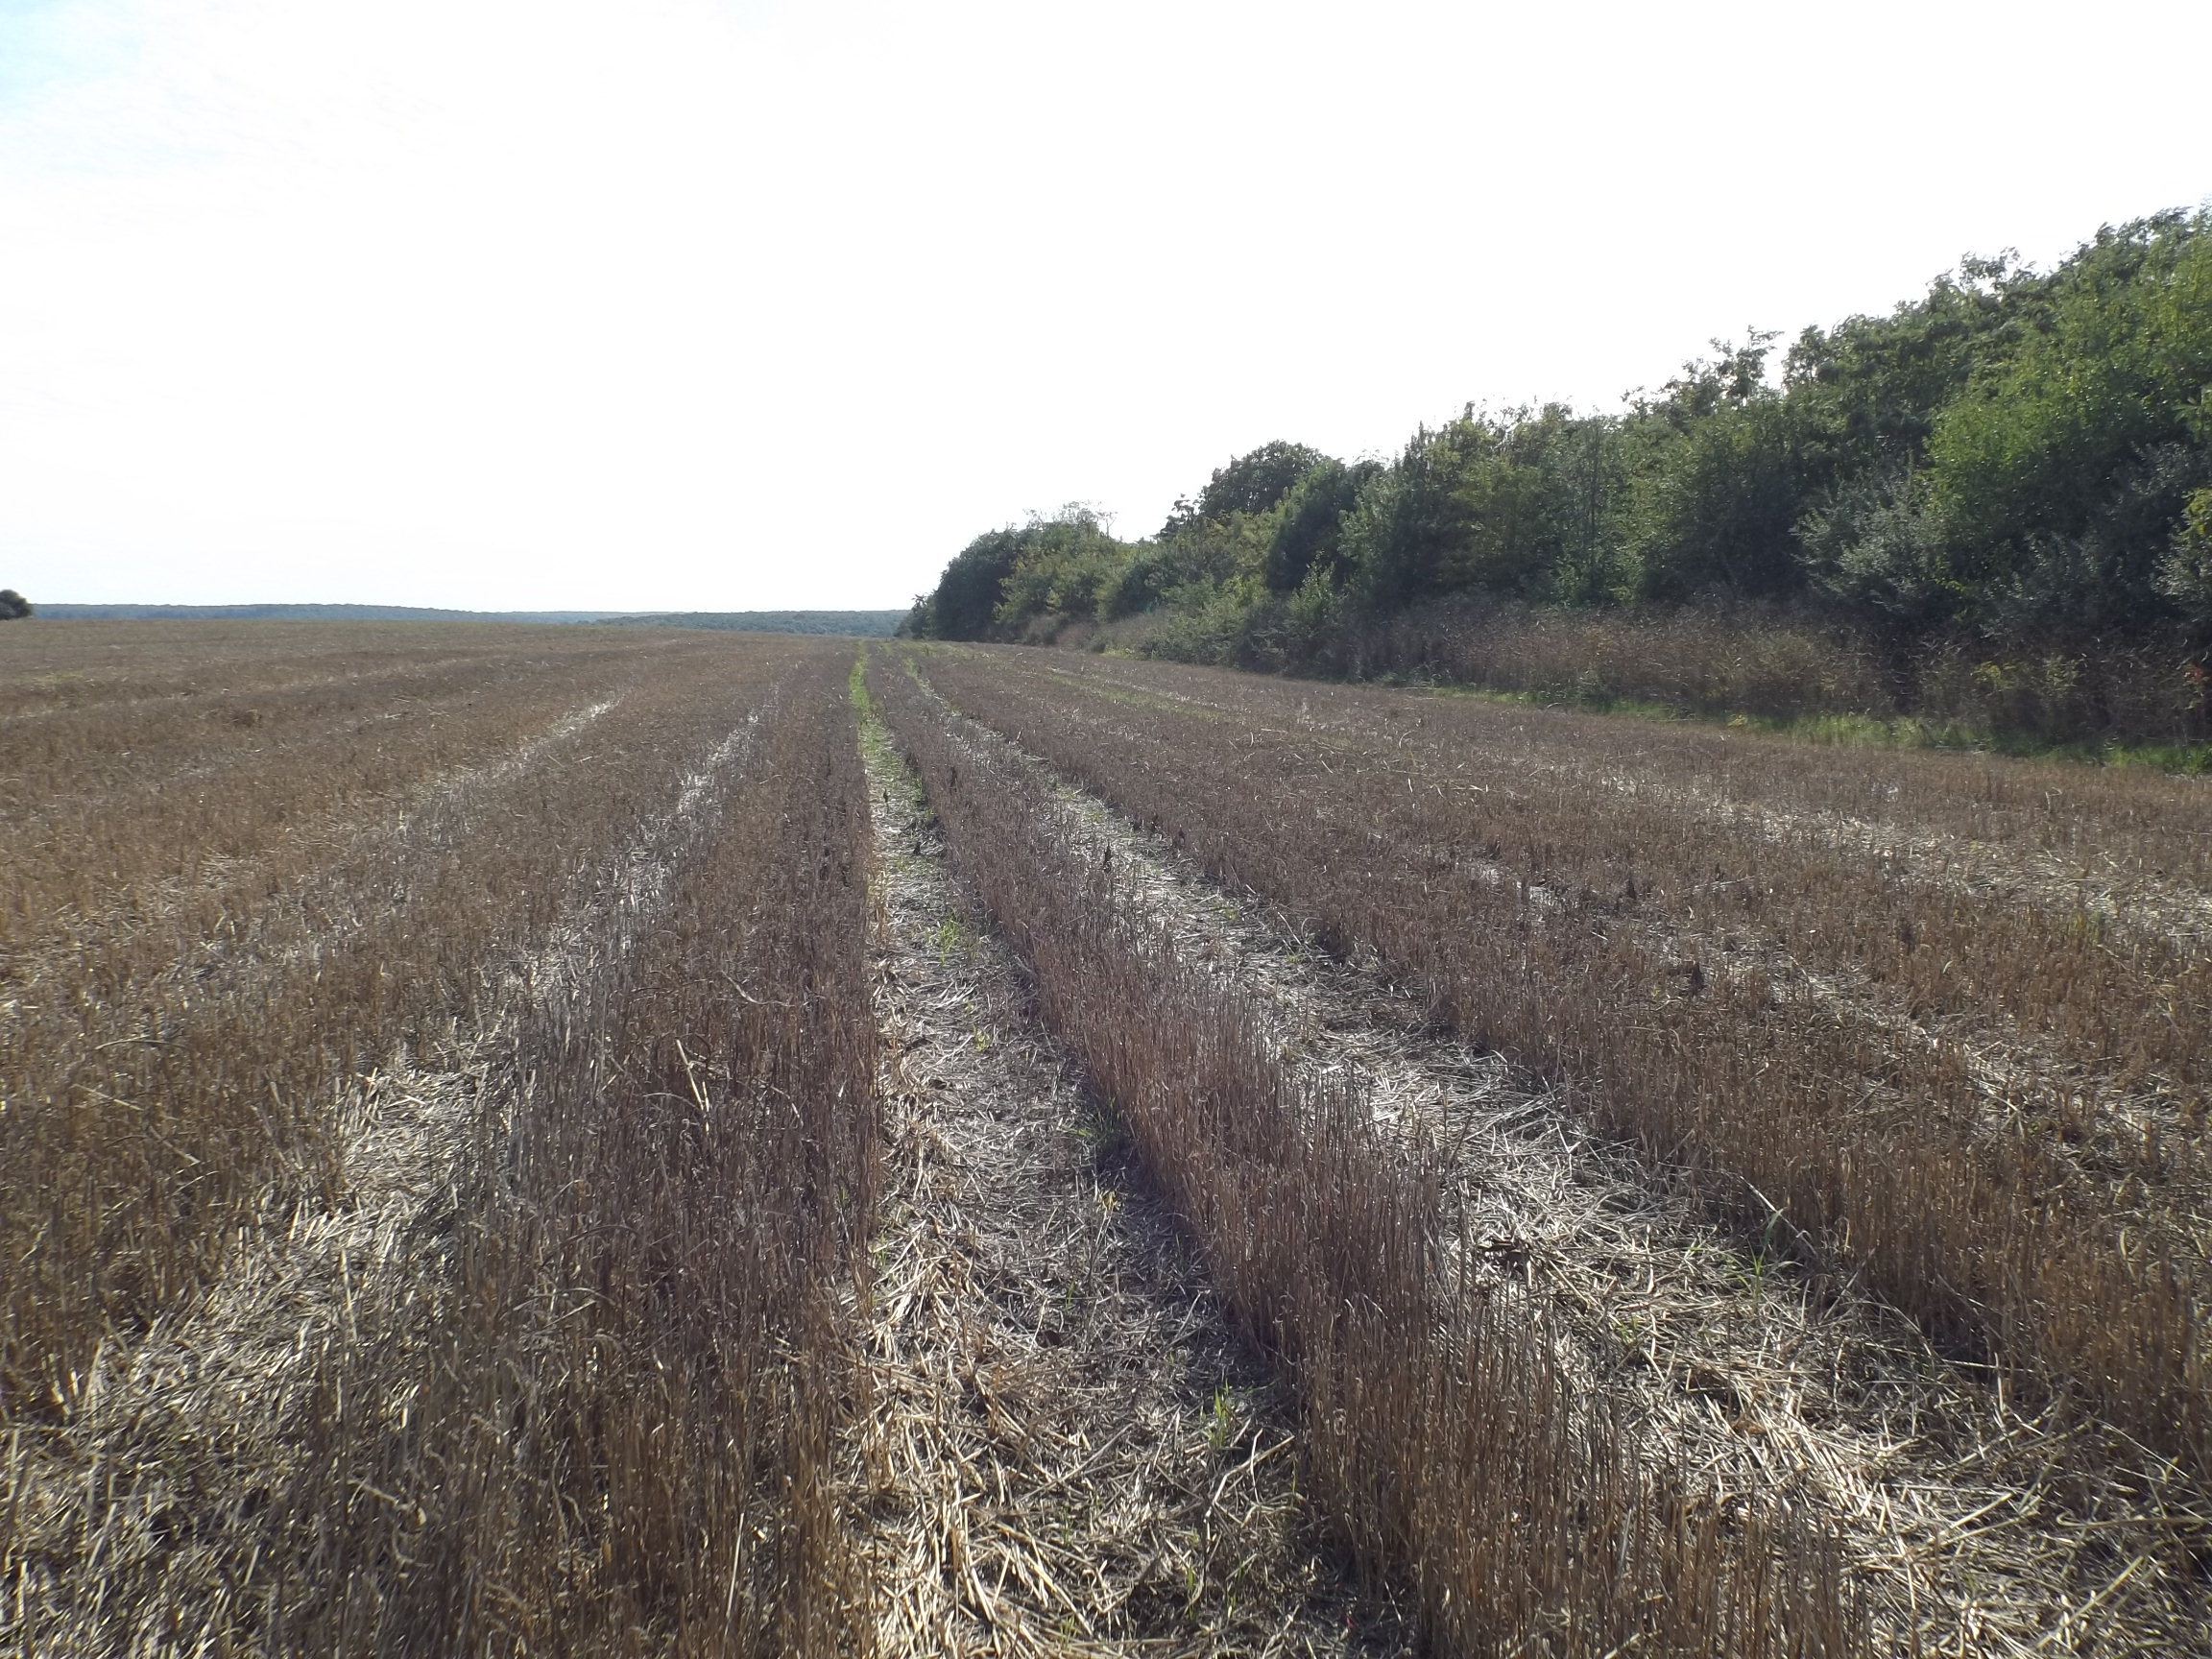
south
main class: Cropland
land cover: Common wheat
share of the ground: 25 - 50 %
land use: Agriculture (excluding fallow land and kitchen gardens)
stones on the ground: < 10 %
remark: Harvested field
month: October
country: BG
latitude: 43.8951
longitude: 26.7600
